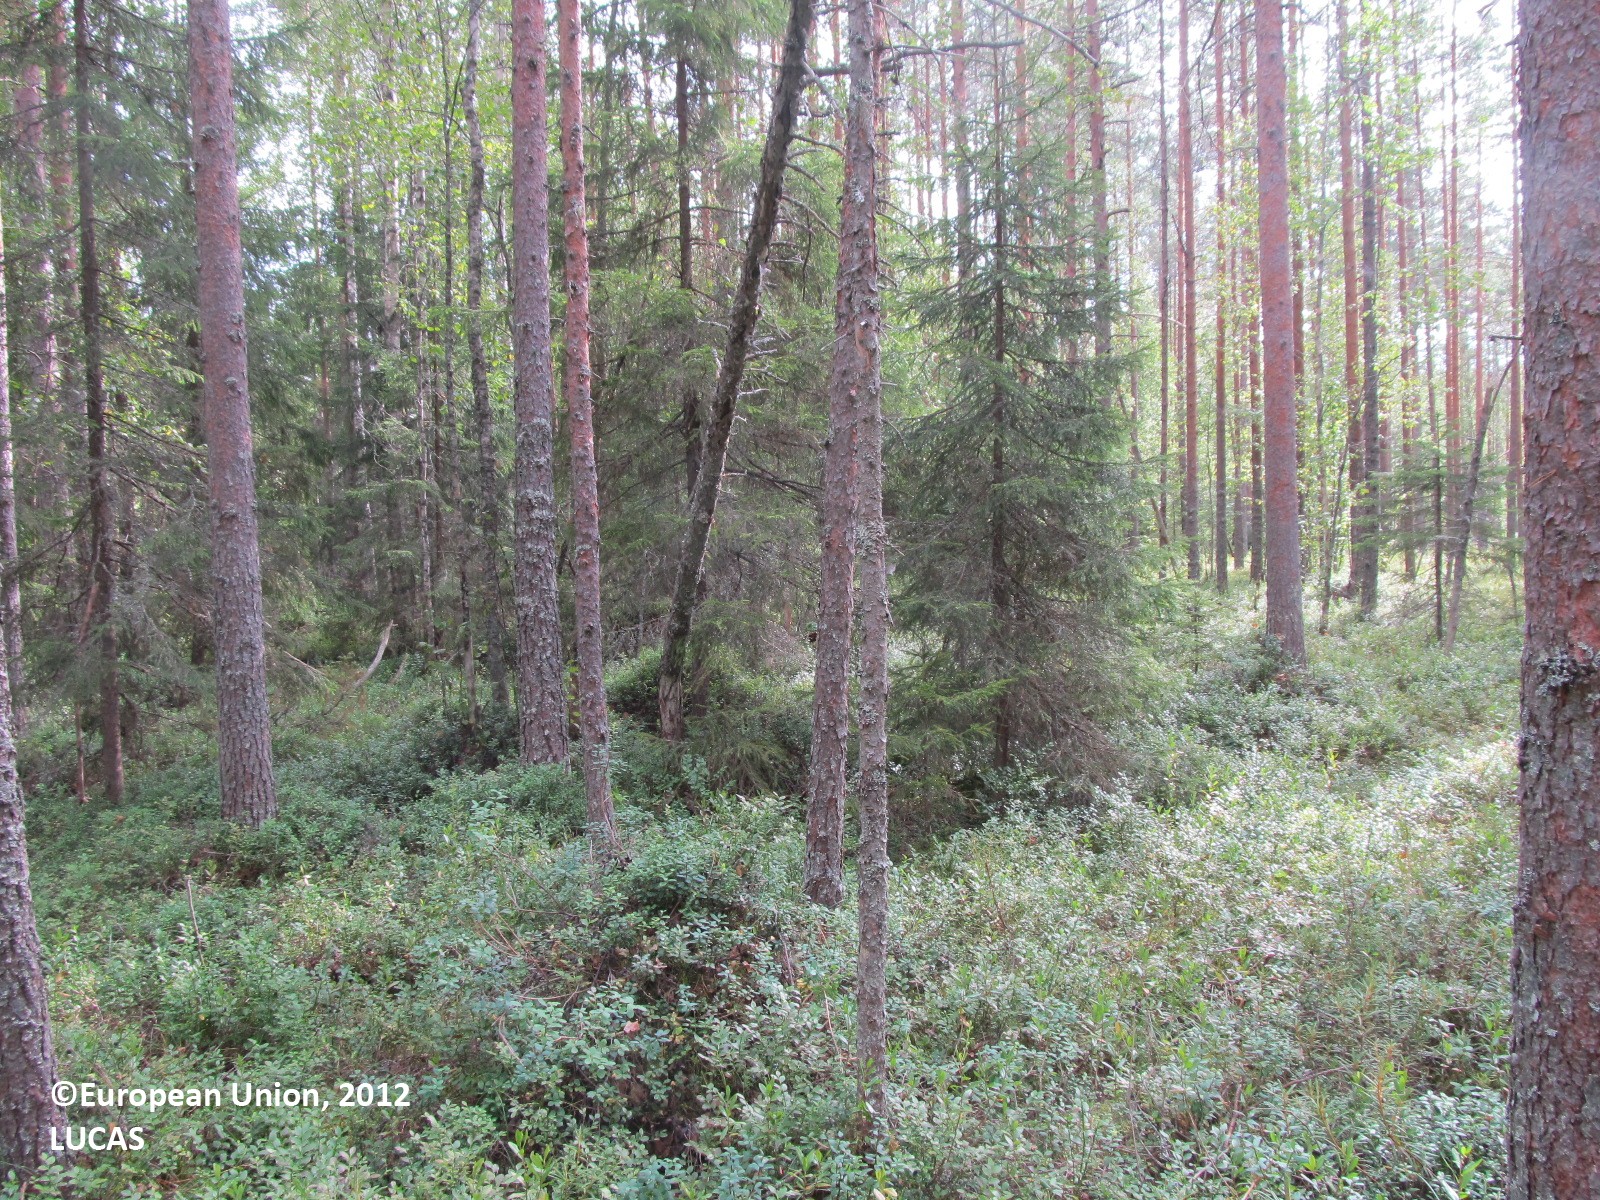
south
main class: Woodland
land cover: Pine dominated coniferous woodland
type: boreal forest
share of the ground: 25 - 50 %
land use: Forestry
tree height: > 5 m
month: August
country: FI
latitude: 62.2922
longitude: 28.4589
